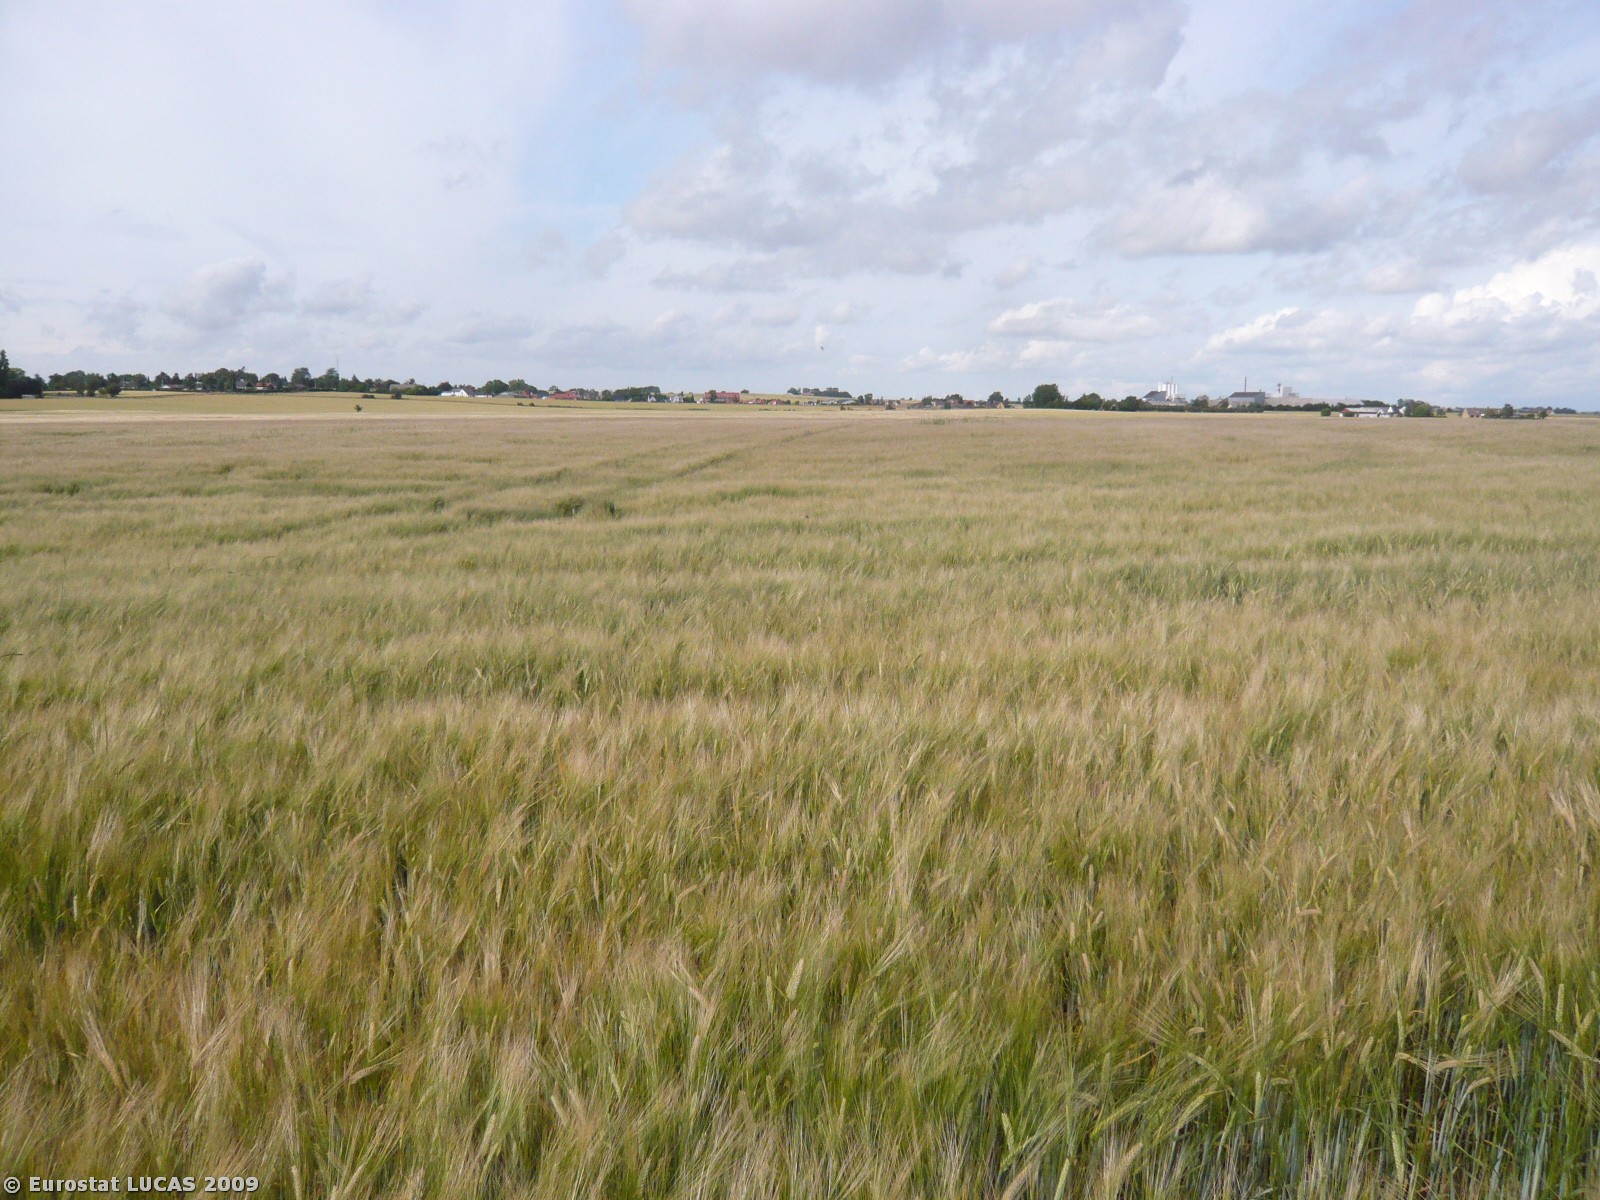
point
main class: Cropland
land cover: Barley
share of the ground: > 75 %
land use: Agriculture (excluding fallow land and kitchen gardens)
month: July
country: DK
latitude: 55.4267
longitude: 11.2472
